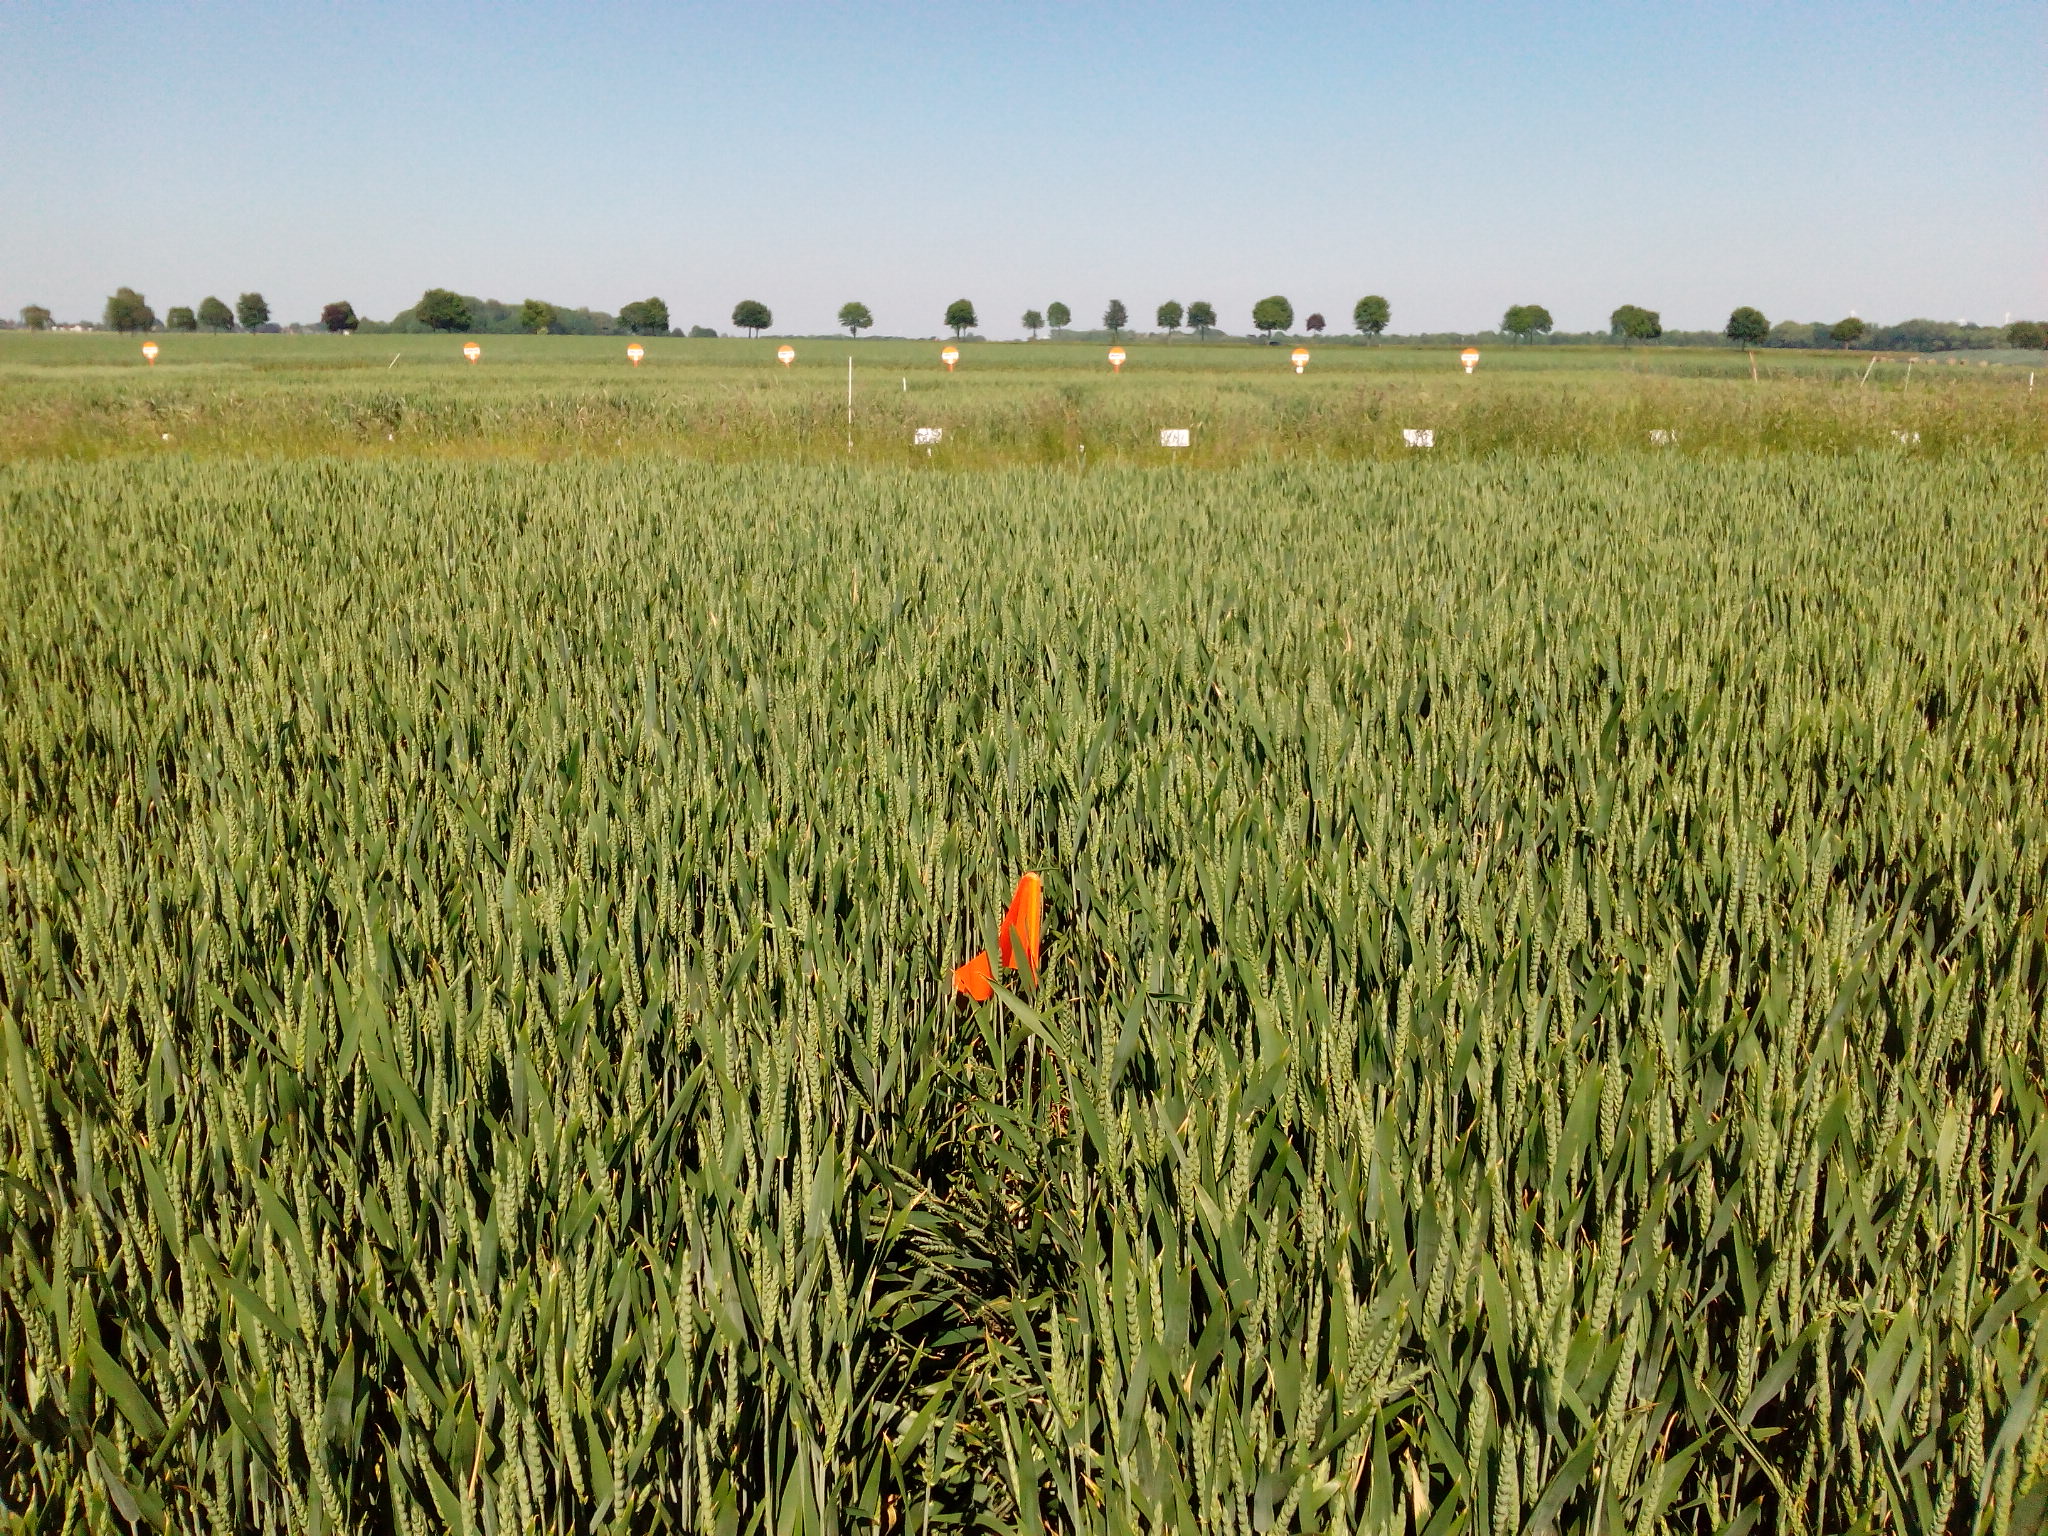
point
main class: Cropland
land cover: Common wheat
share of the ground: > 75 %
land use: Agriculture (excluding fallow land and kitchen gardens)
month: June
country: DE
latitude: 52.2516
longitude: 9.9268
